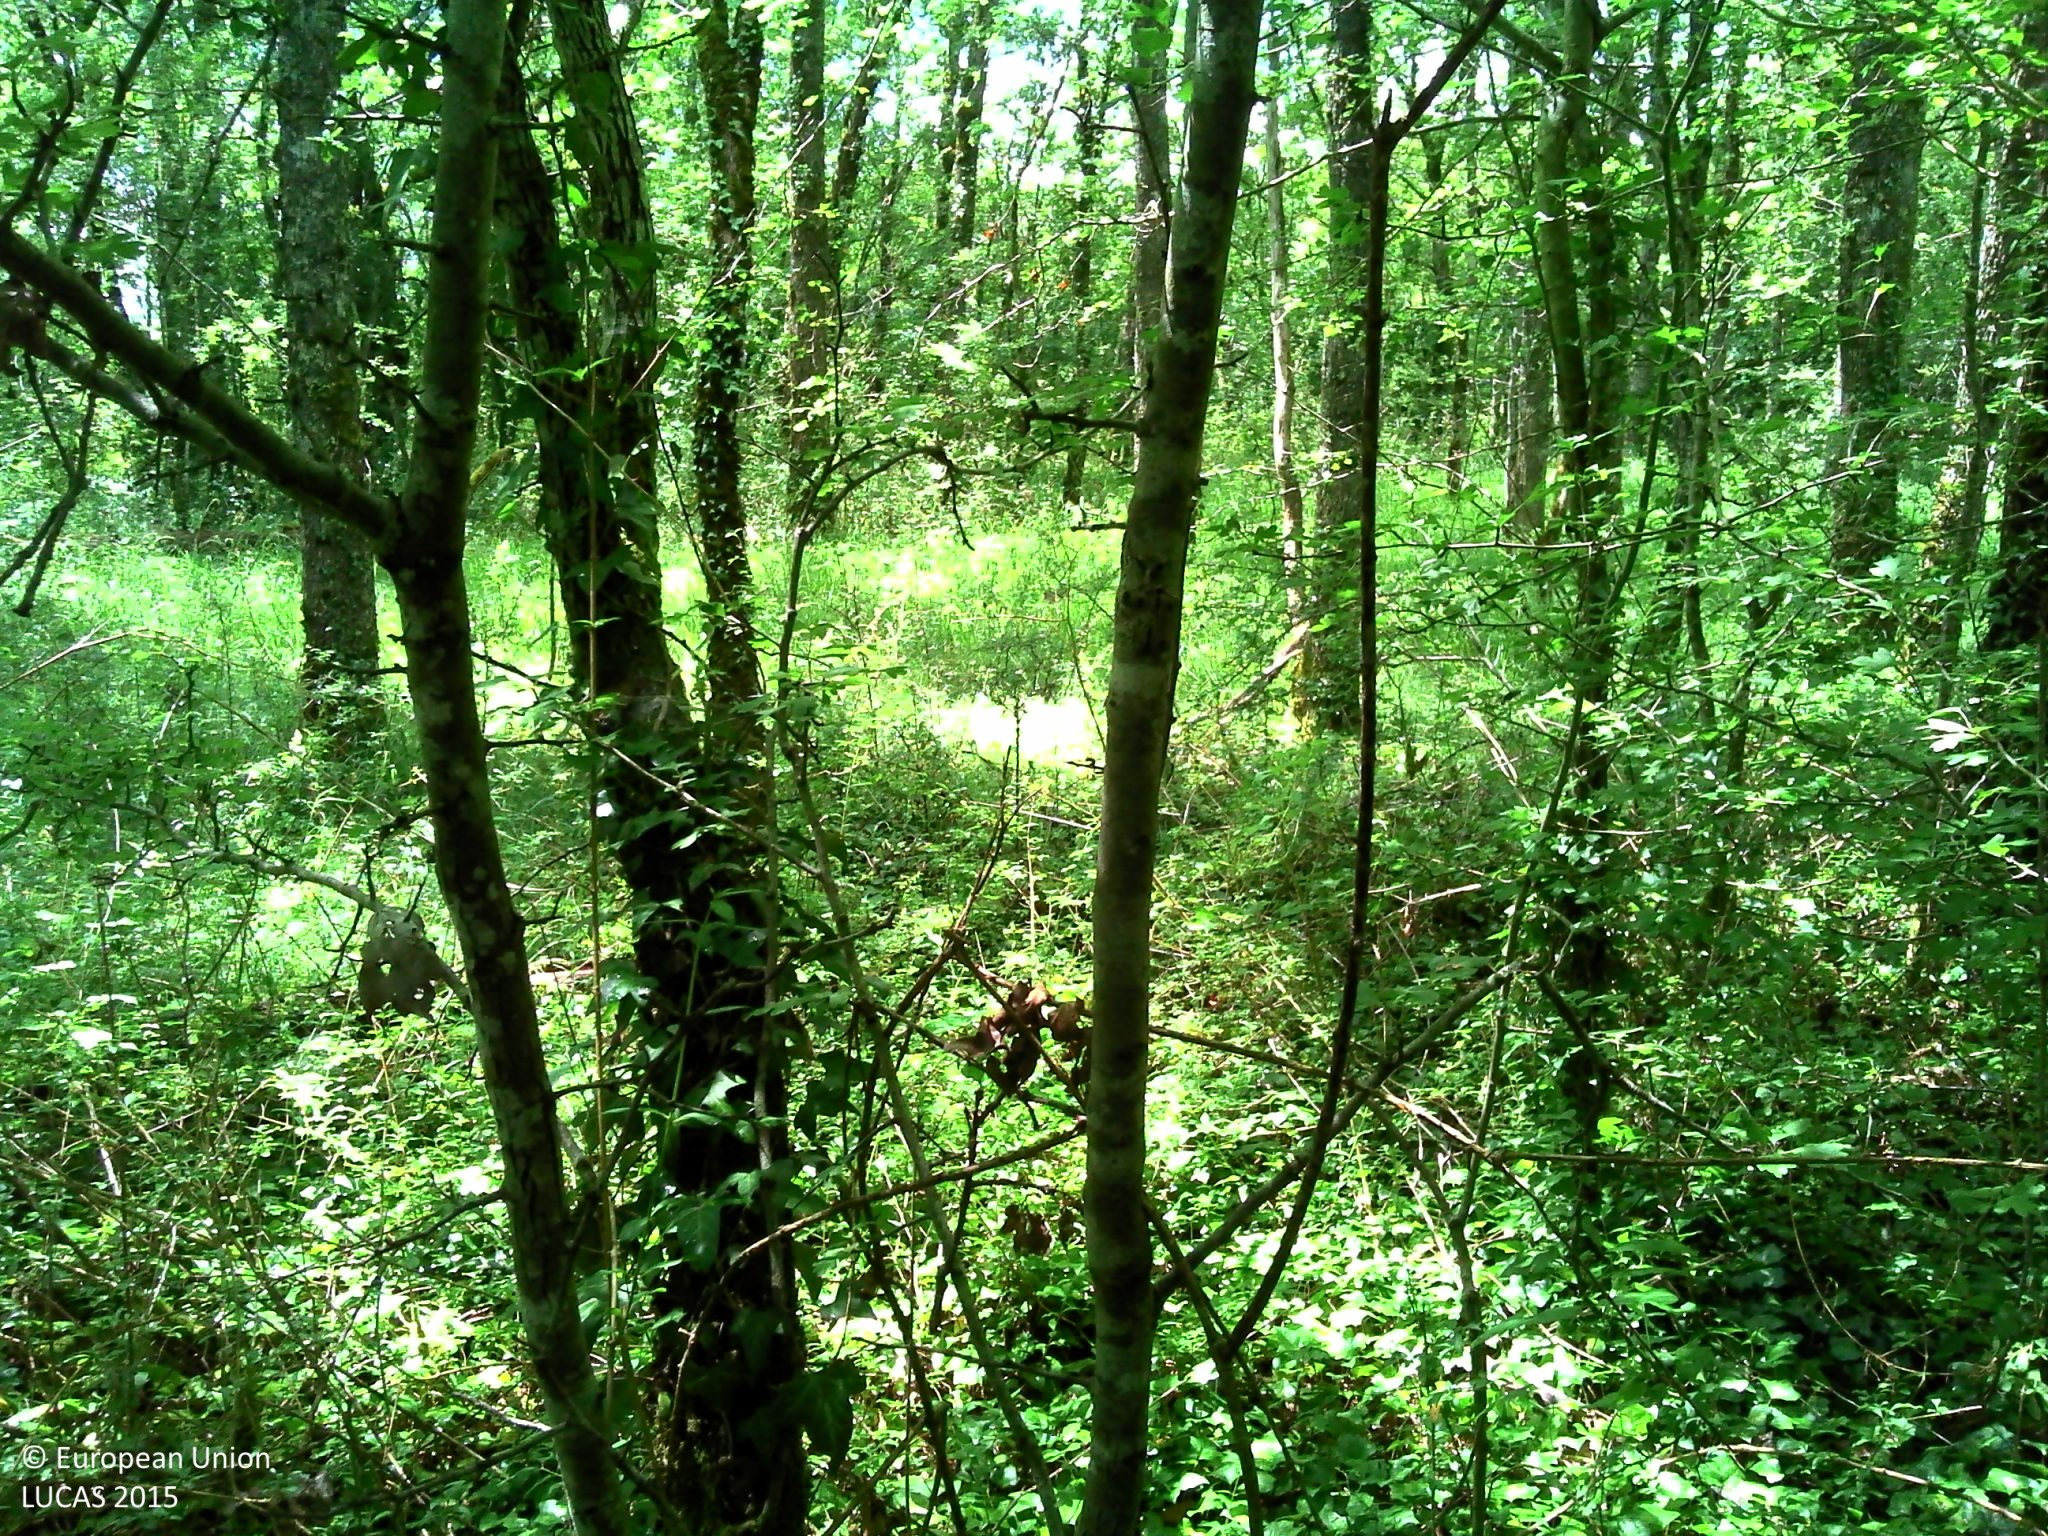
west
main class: Woodland
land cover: Broadleaved woodland
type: acidophilous oak and oak-birch forest
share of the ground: > 75 %
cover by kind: broadleaved forest trees 75 %, herbaceous plants 15 %, shrubs 5 %, lichens and mosses 5 %
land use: Forestry
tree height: > 5 m
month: June
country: FR
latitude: 44.2867
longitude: 1.8933
